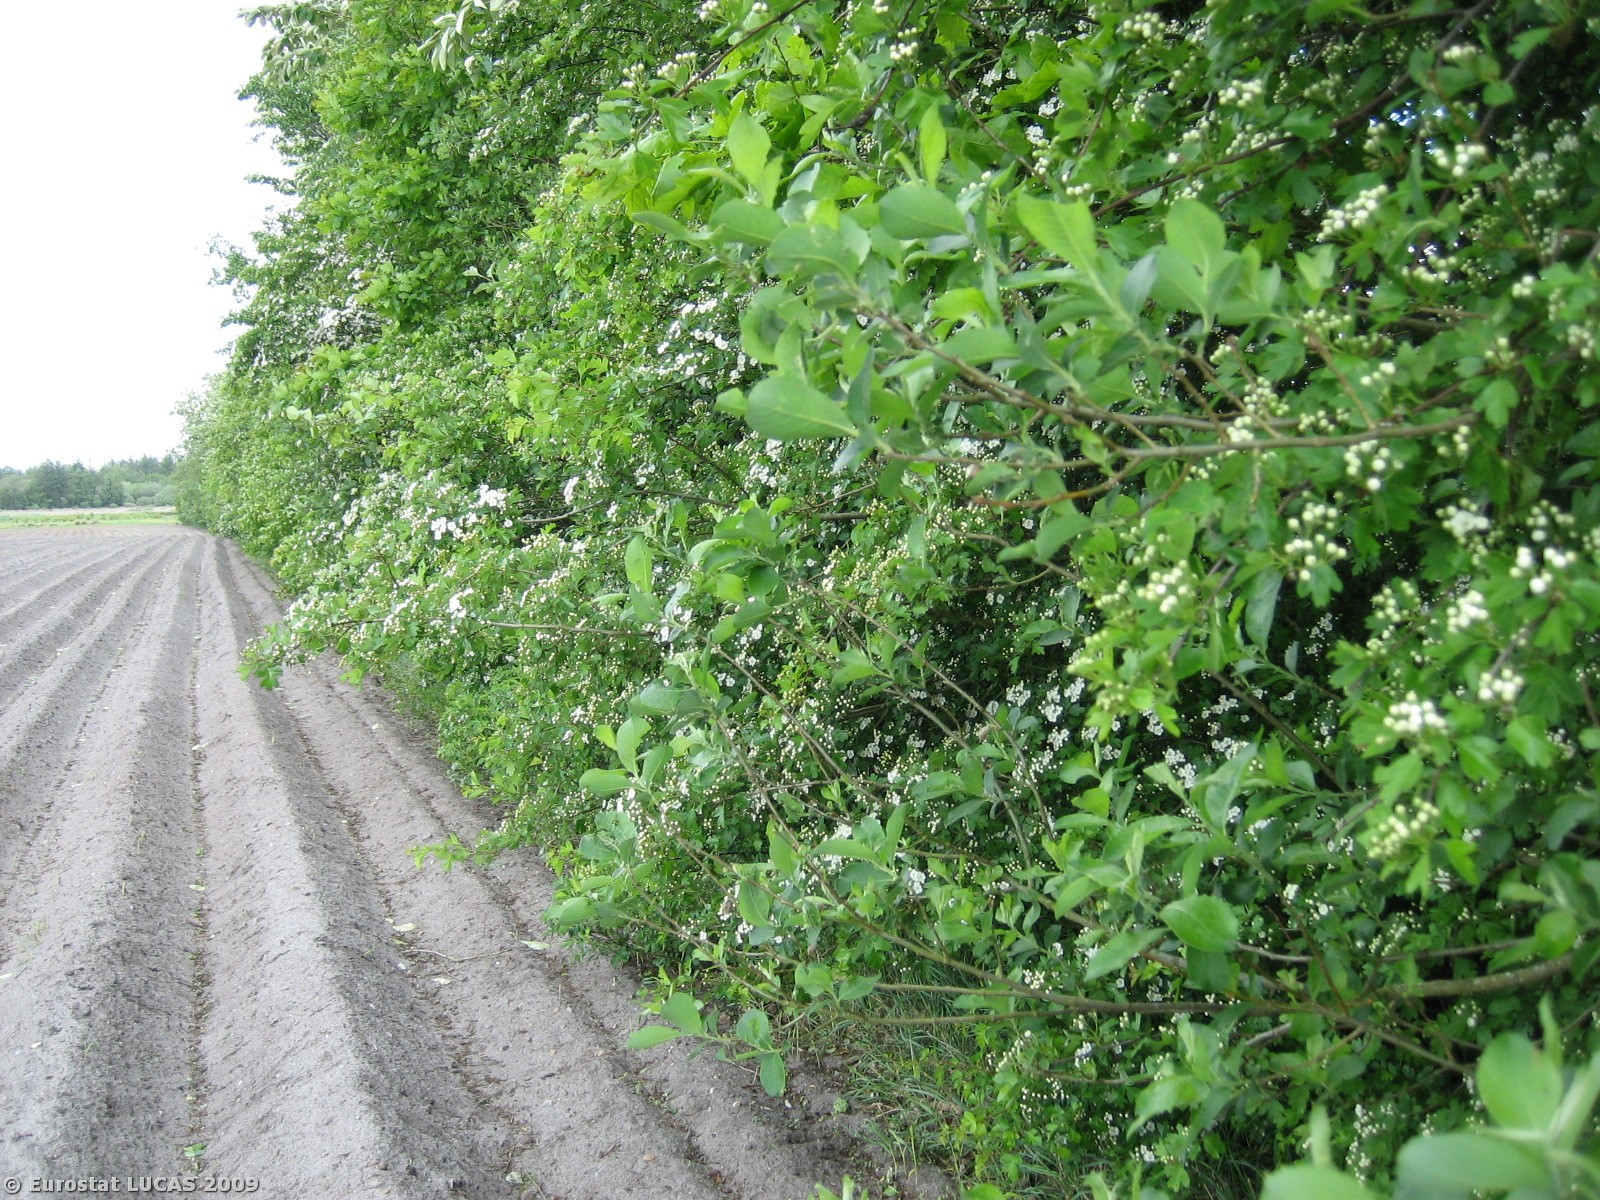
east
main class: Woodland
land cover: Broadleaved woodland
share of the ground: > 75 %
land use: Unused
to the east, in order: Broadleaved woodland; Fences; Barley
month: May
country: DK
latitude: 56.2911
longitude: 8.9188
